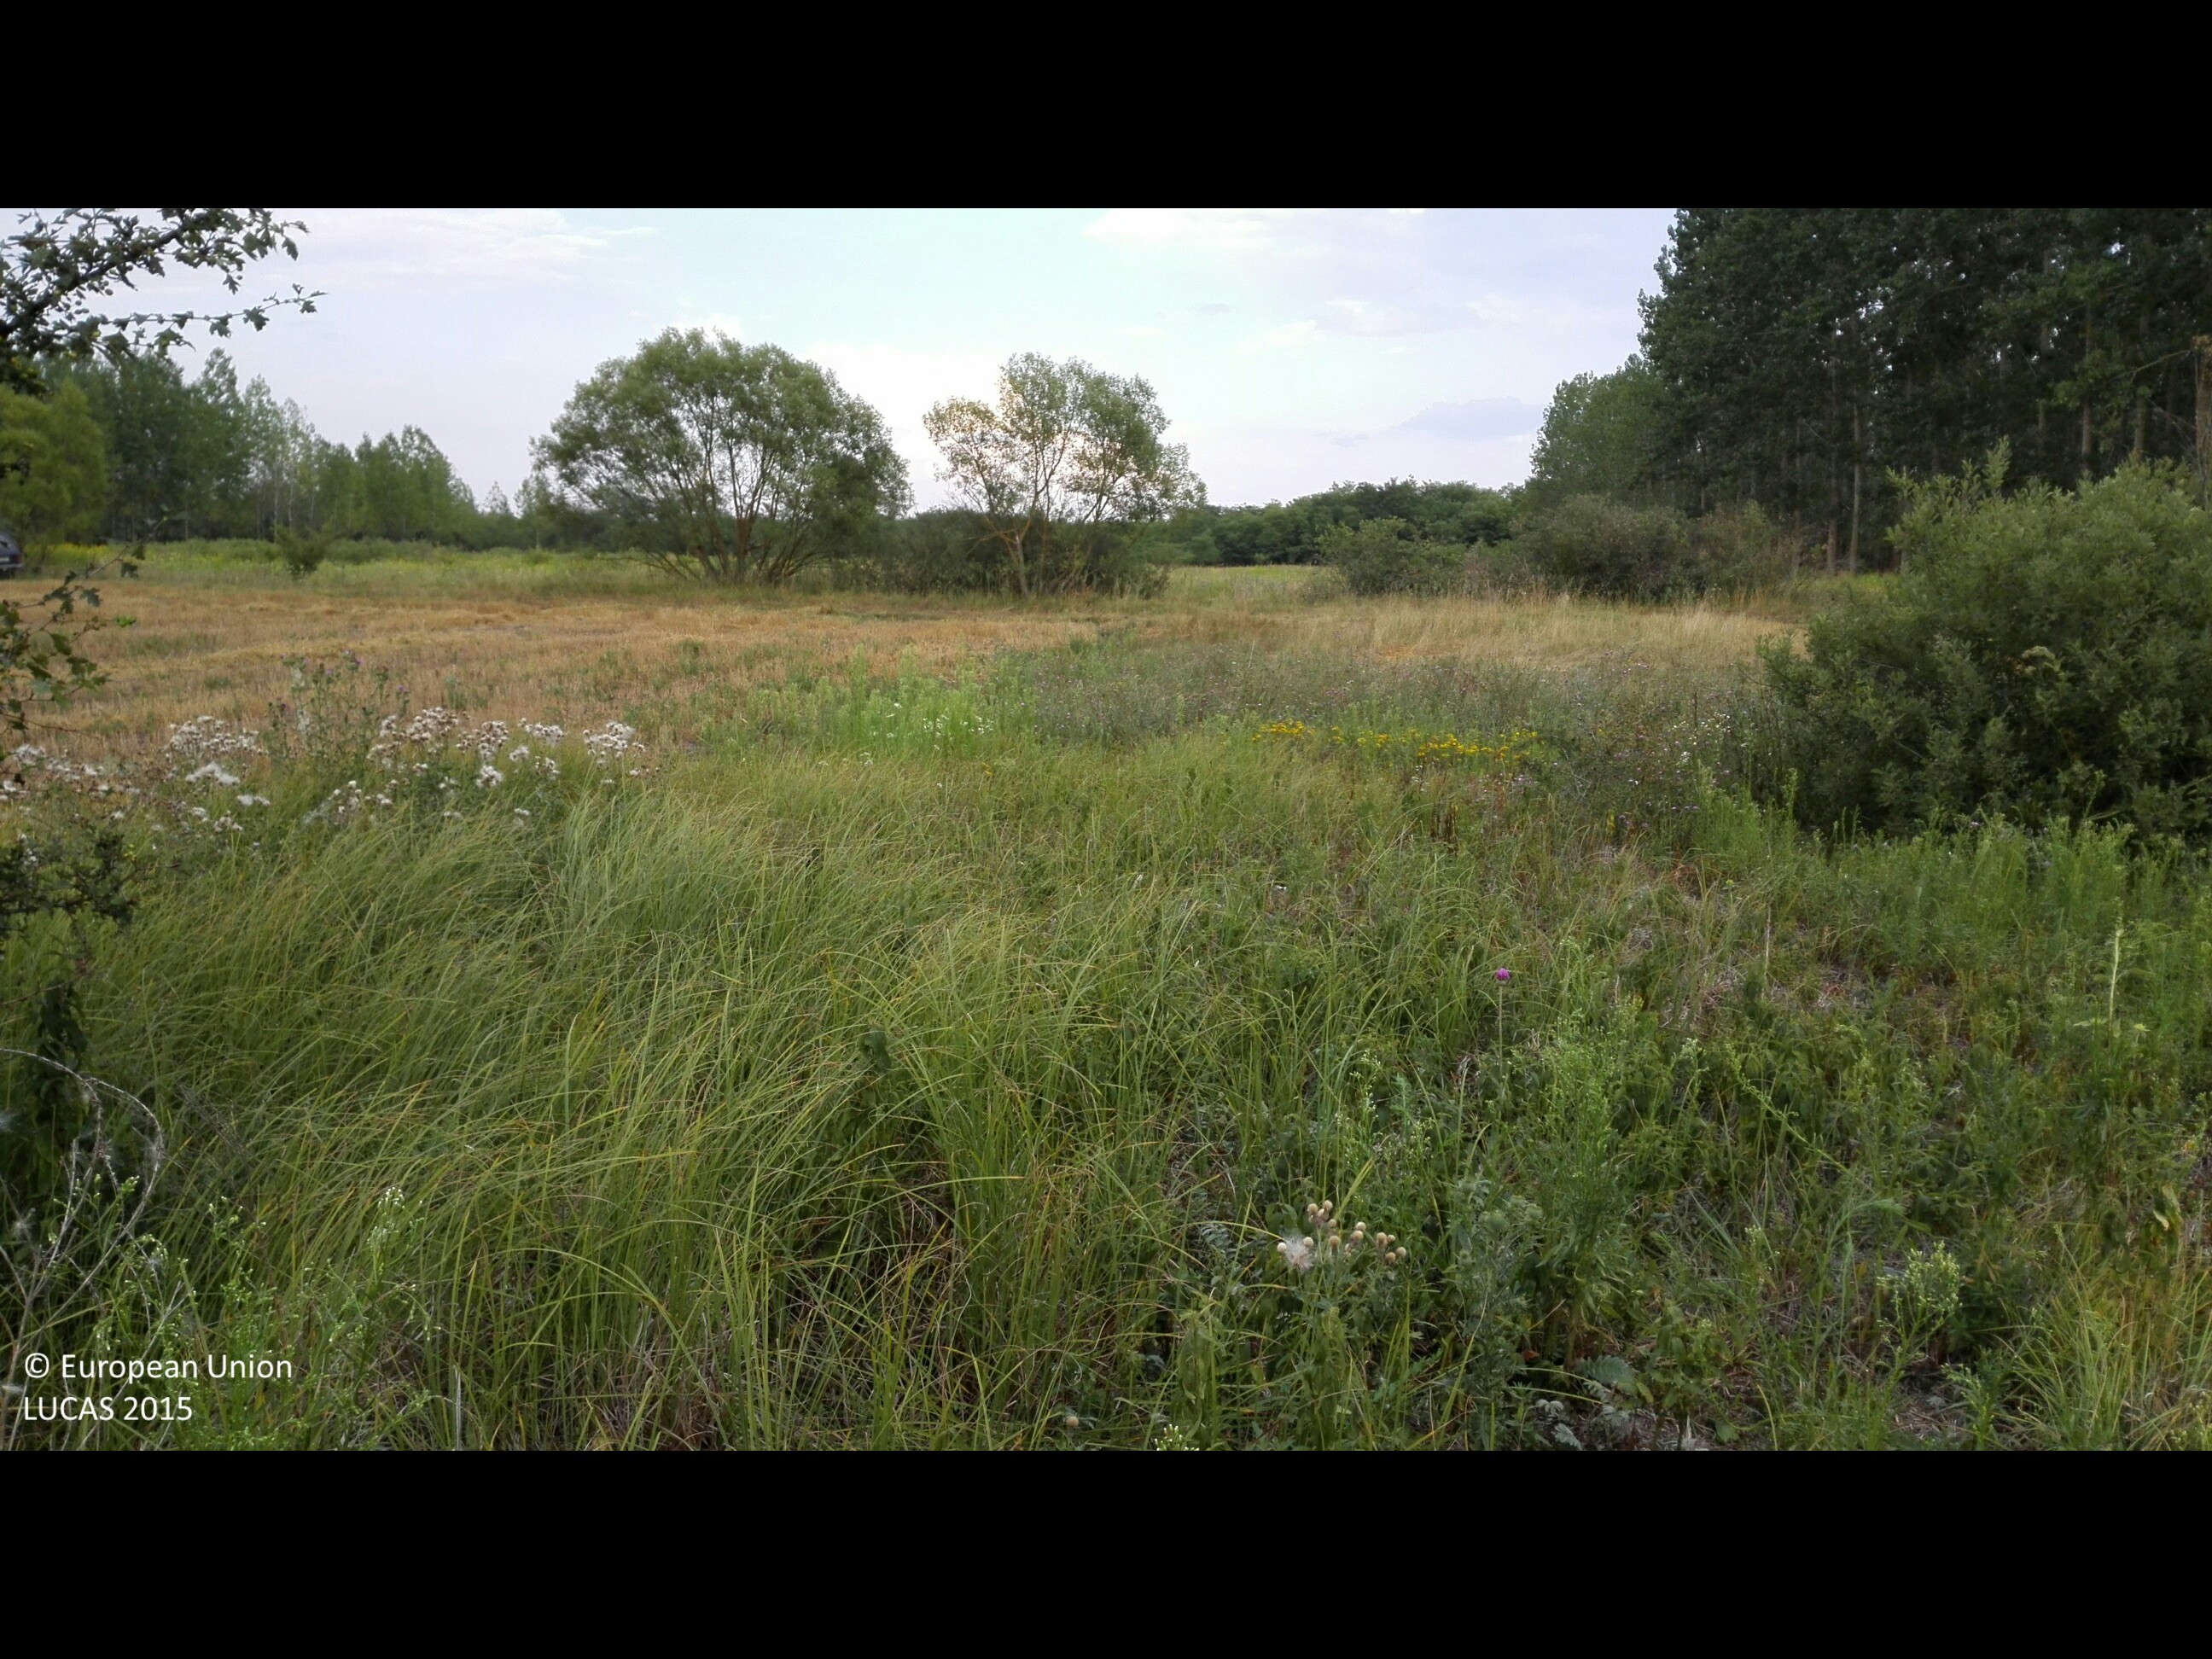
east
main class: Grassland
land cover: Spontaneously vegetated surfaces
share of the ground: > 75 %
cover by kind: herbaceous plants 100 %
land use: Fallow land
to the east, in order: Spontaneously vegetated surfaces; Common wheat; Grass margins; Tracks; Abandoned hedges; Ditches and canals; Grass margins; Tracks; Grassland without tree/shrub cover; Grassland with sparse tree/shrub cover; Broadleaved woodland
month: August
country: HU
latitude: 47.6009
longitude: 22.0075
